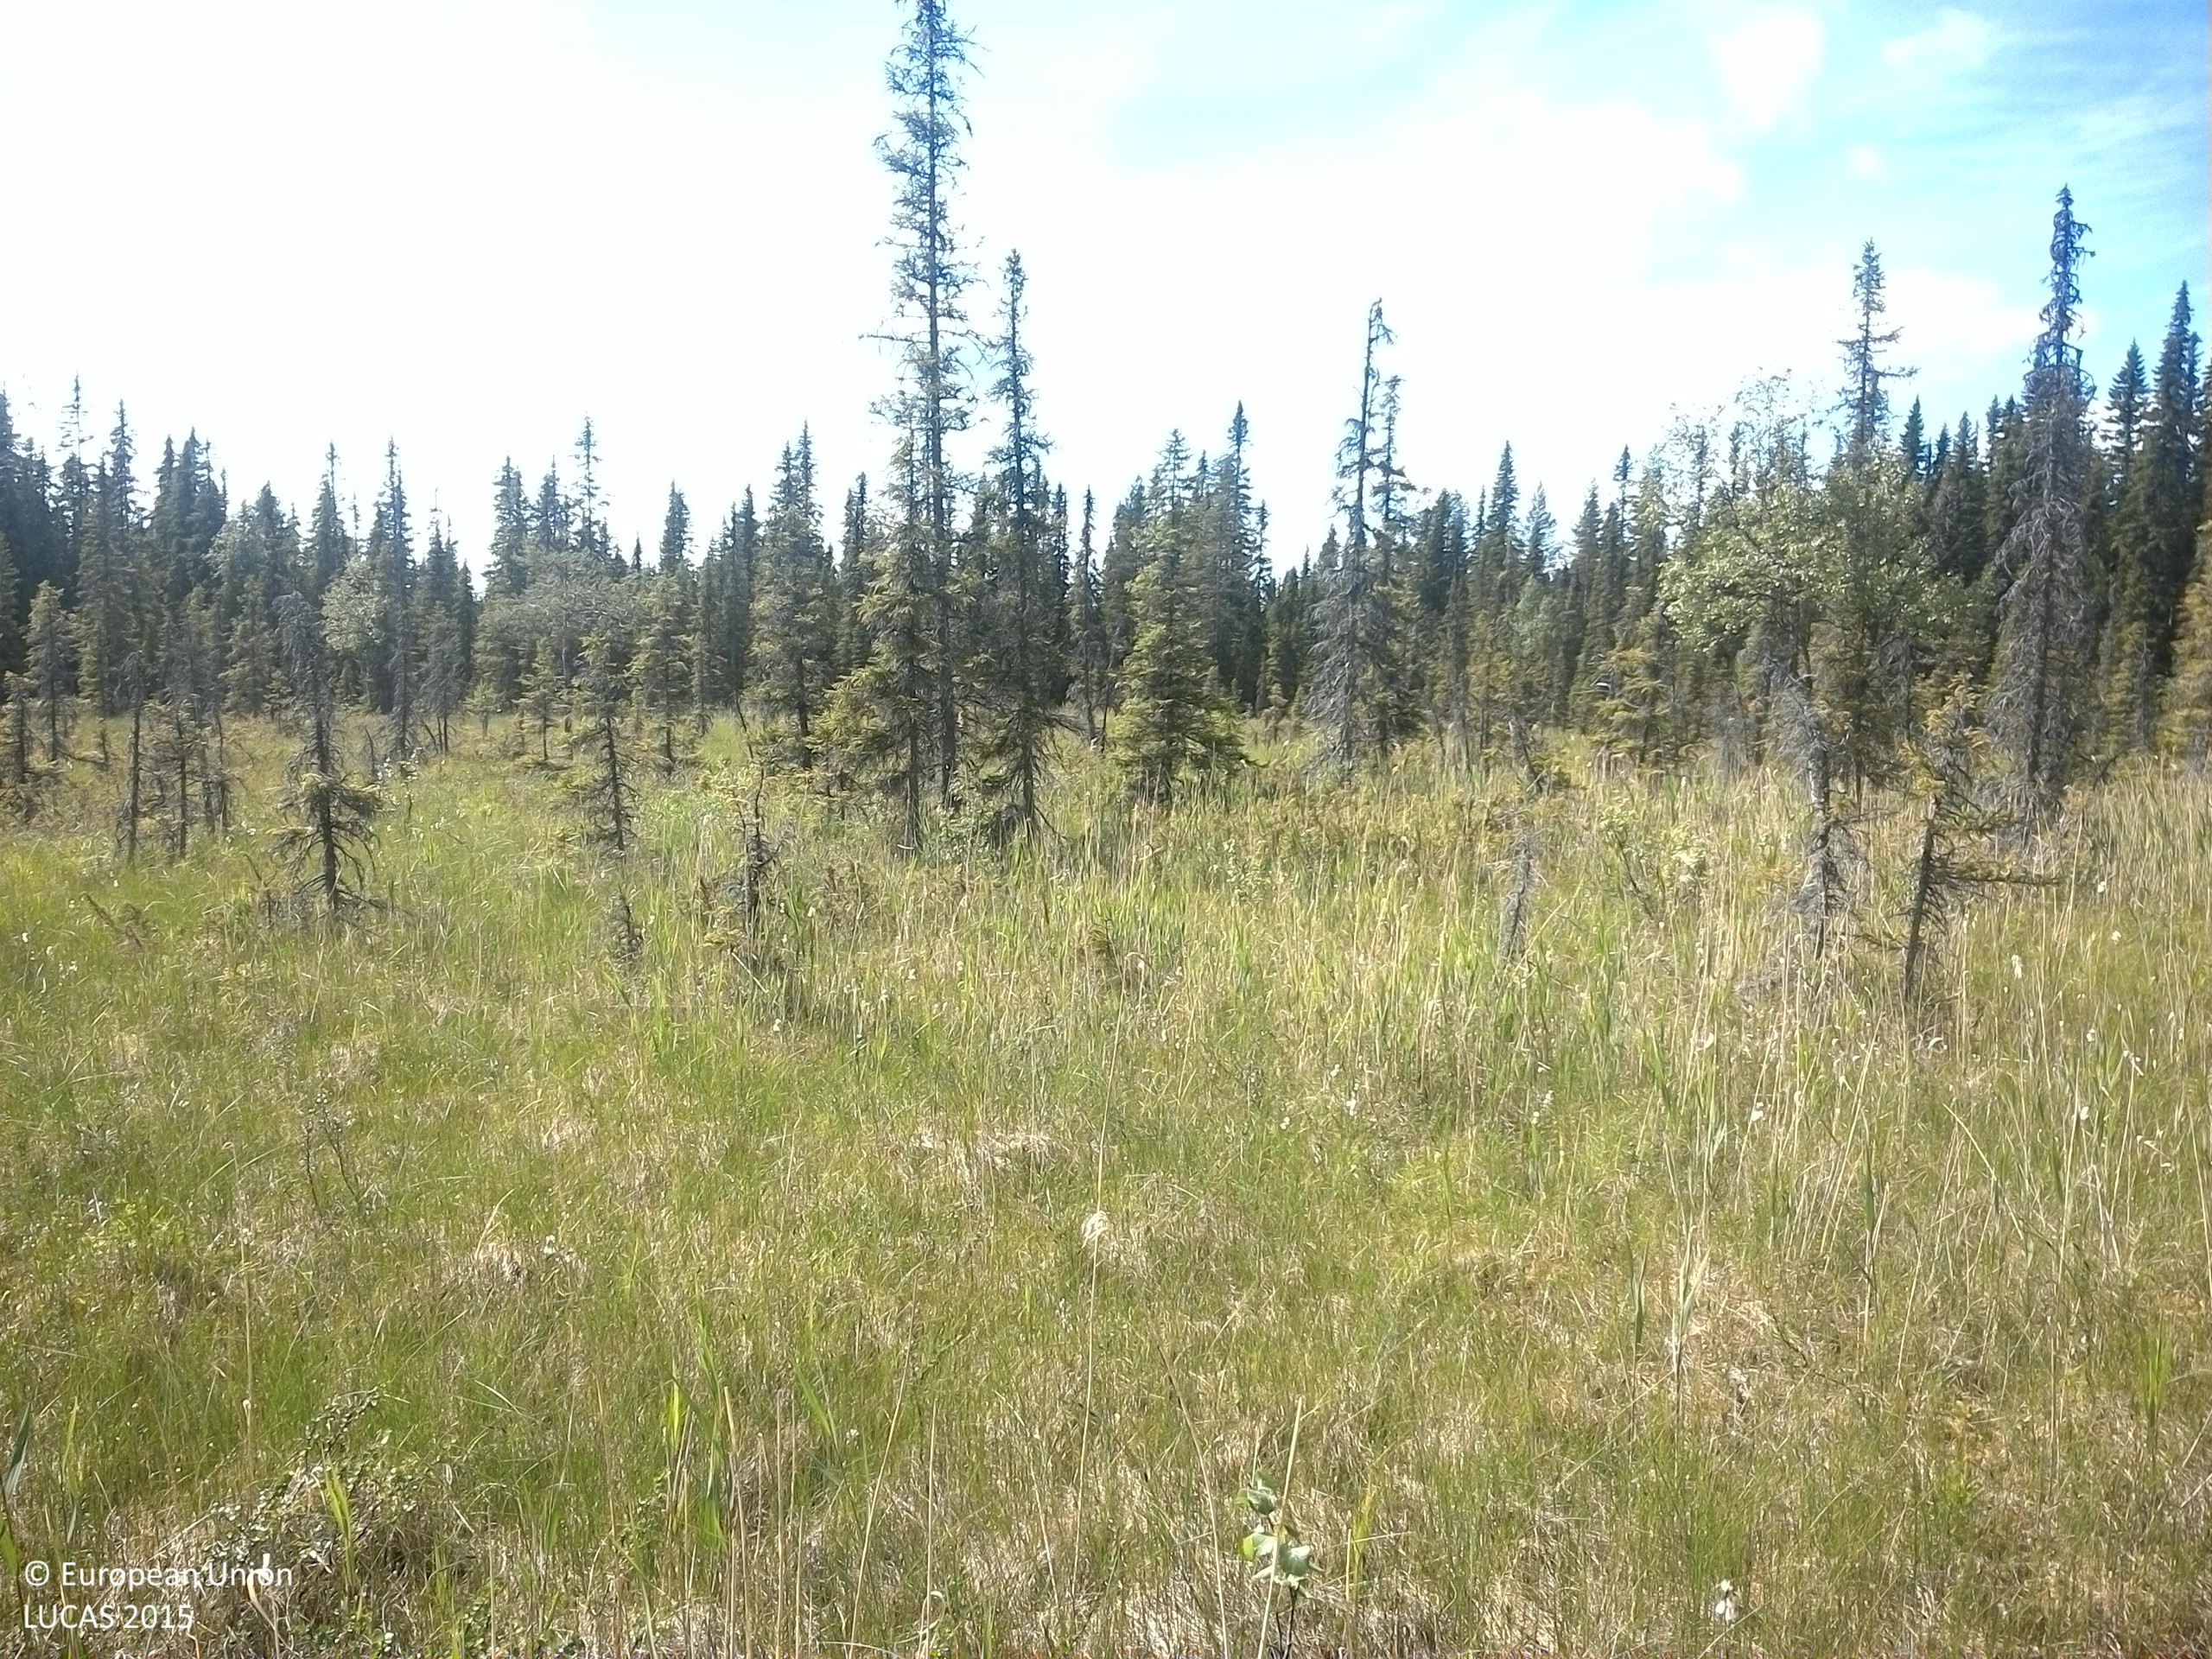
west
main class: Woodland
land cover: Spruce dominated coniferous woodland
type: mire and swamp forests
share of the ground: 10 - 25 %
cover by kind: herbaceous plants 60 %, lichens and mosses 20 %, coniferous forest trees 10 %, shrubs 10 %
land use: Semi-natural and natural areas not in use
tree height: < 5 m
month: July
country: SE
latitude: 64.4727
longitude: 15.8136
